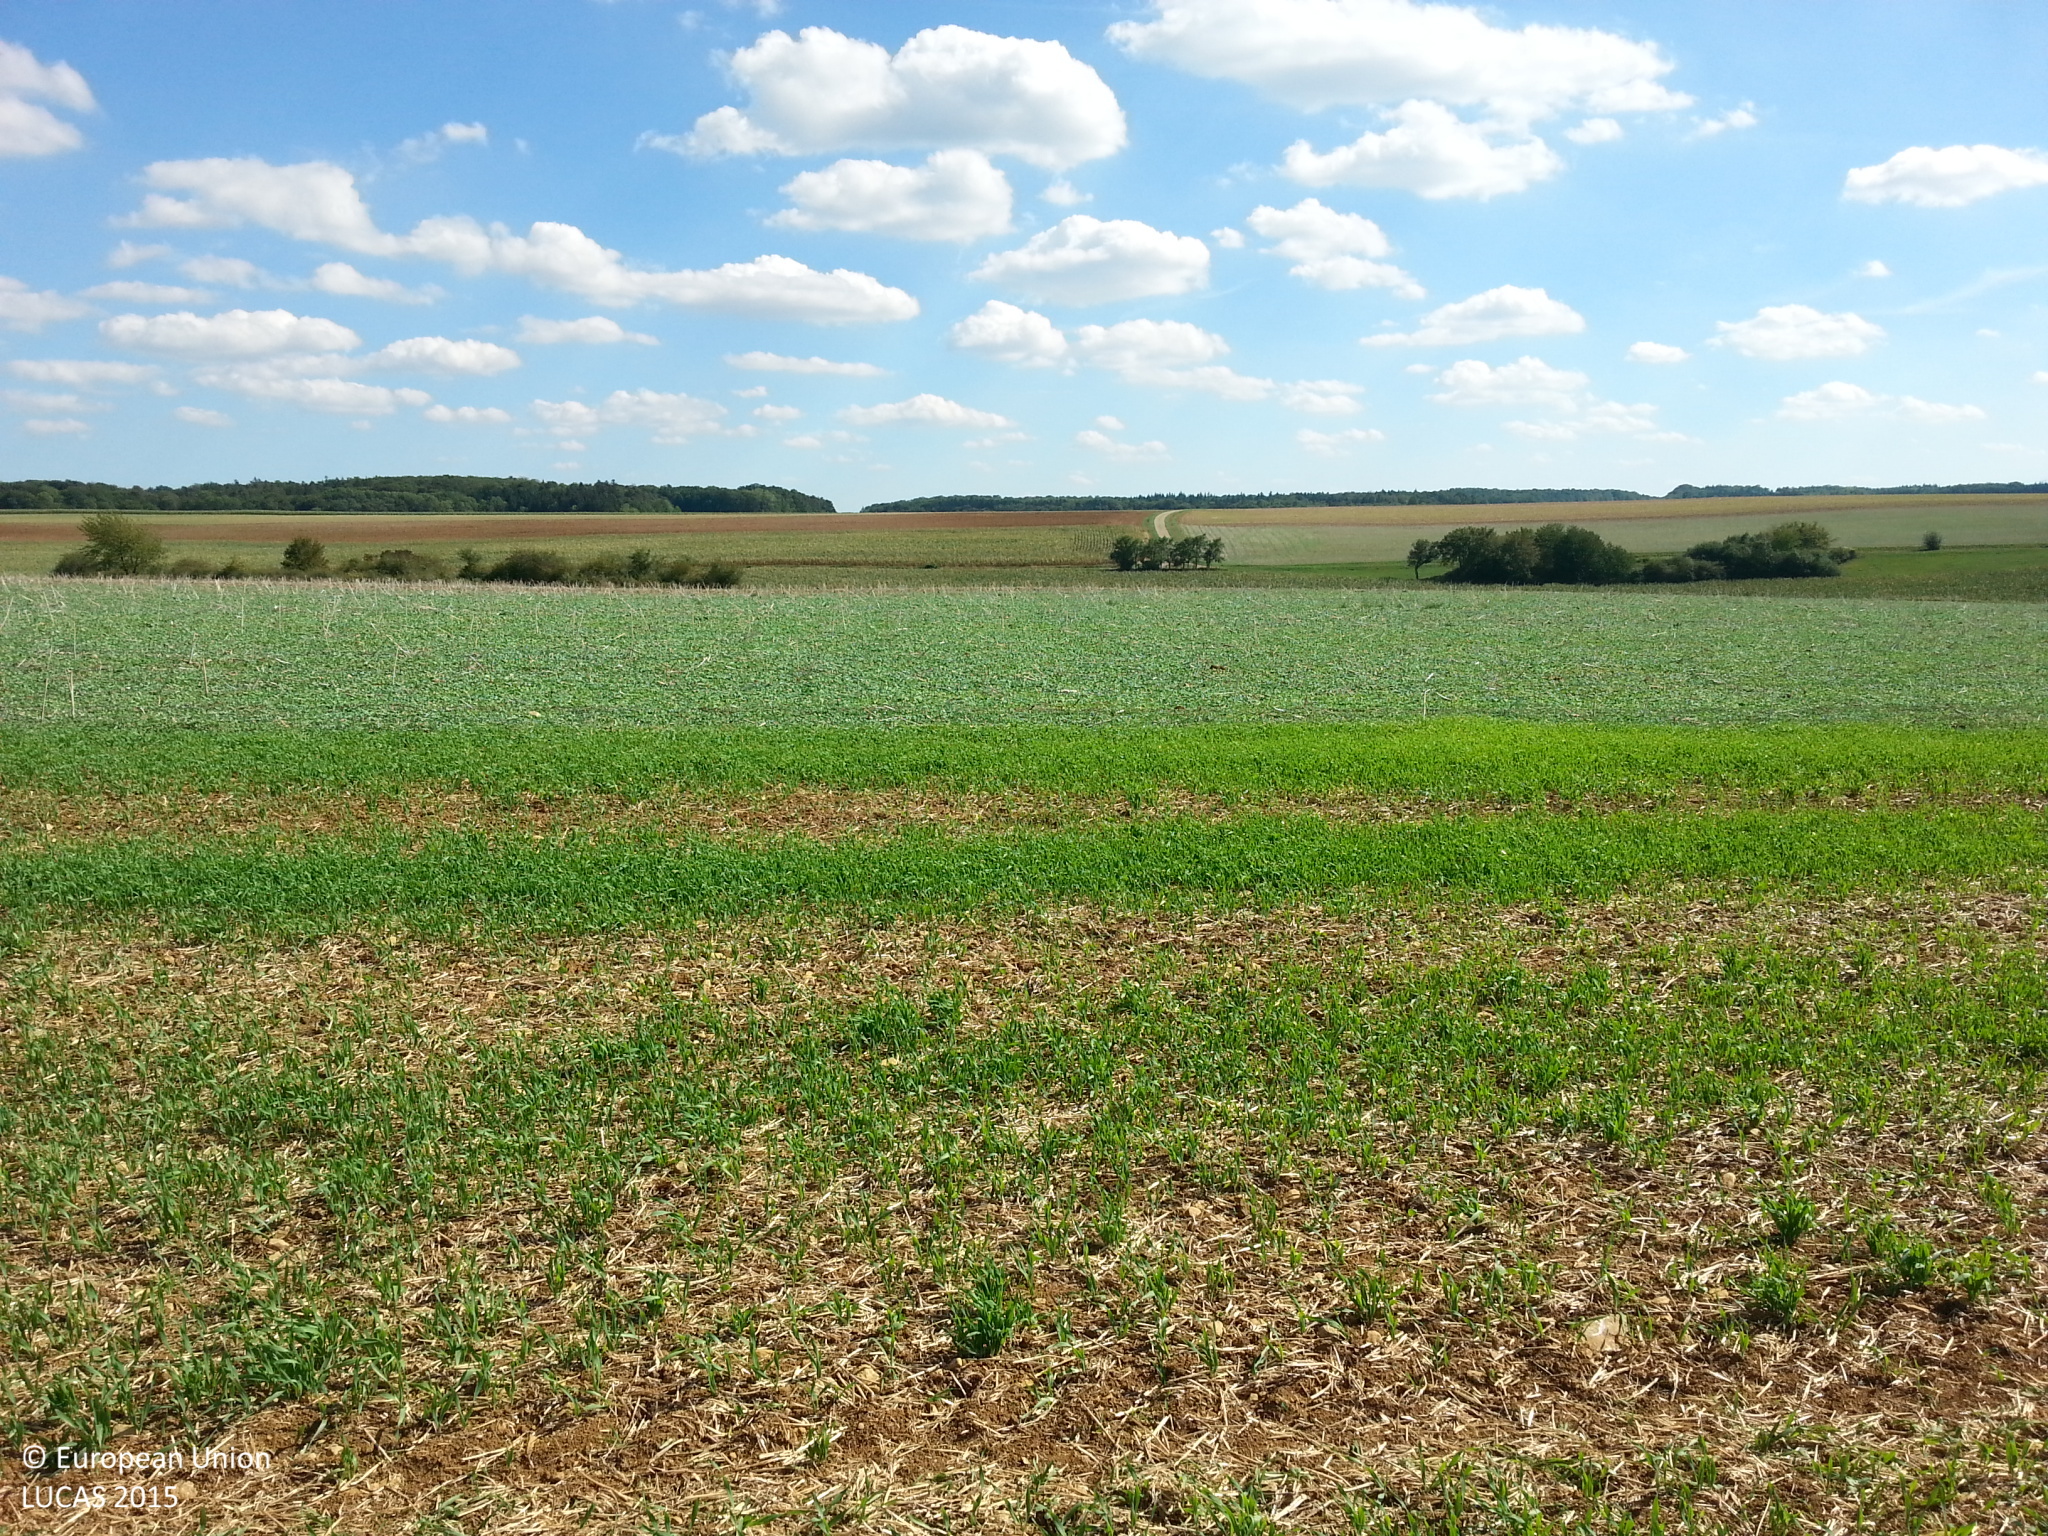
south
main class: Cropland
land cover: Temporary grasslands
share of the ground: 50 - 75 %
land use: Agriculture (excluding fallow land and kitchen gardens)
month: August
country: DE
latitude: 49.4289
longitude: 9.9587
